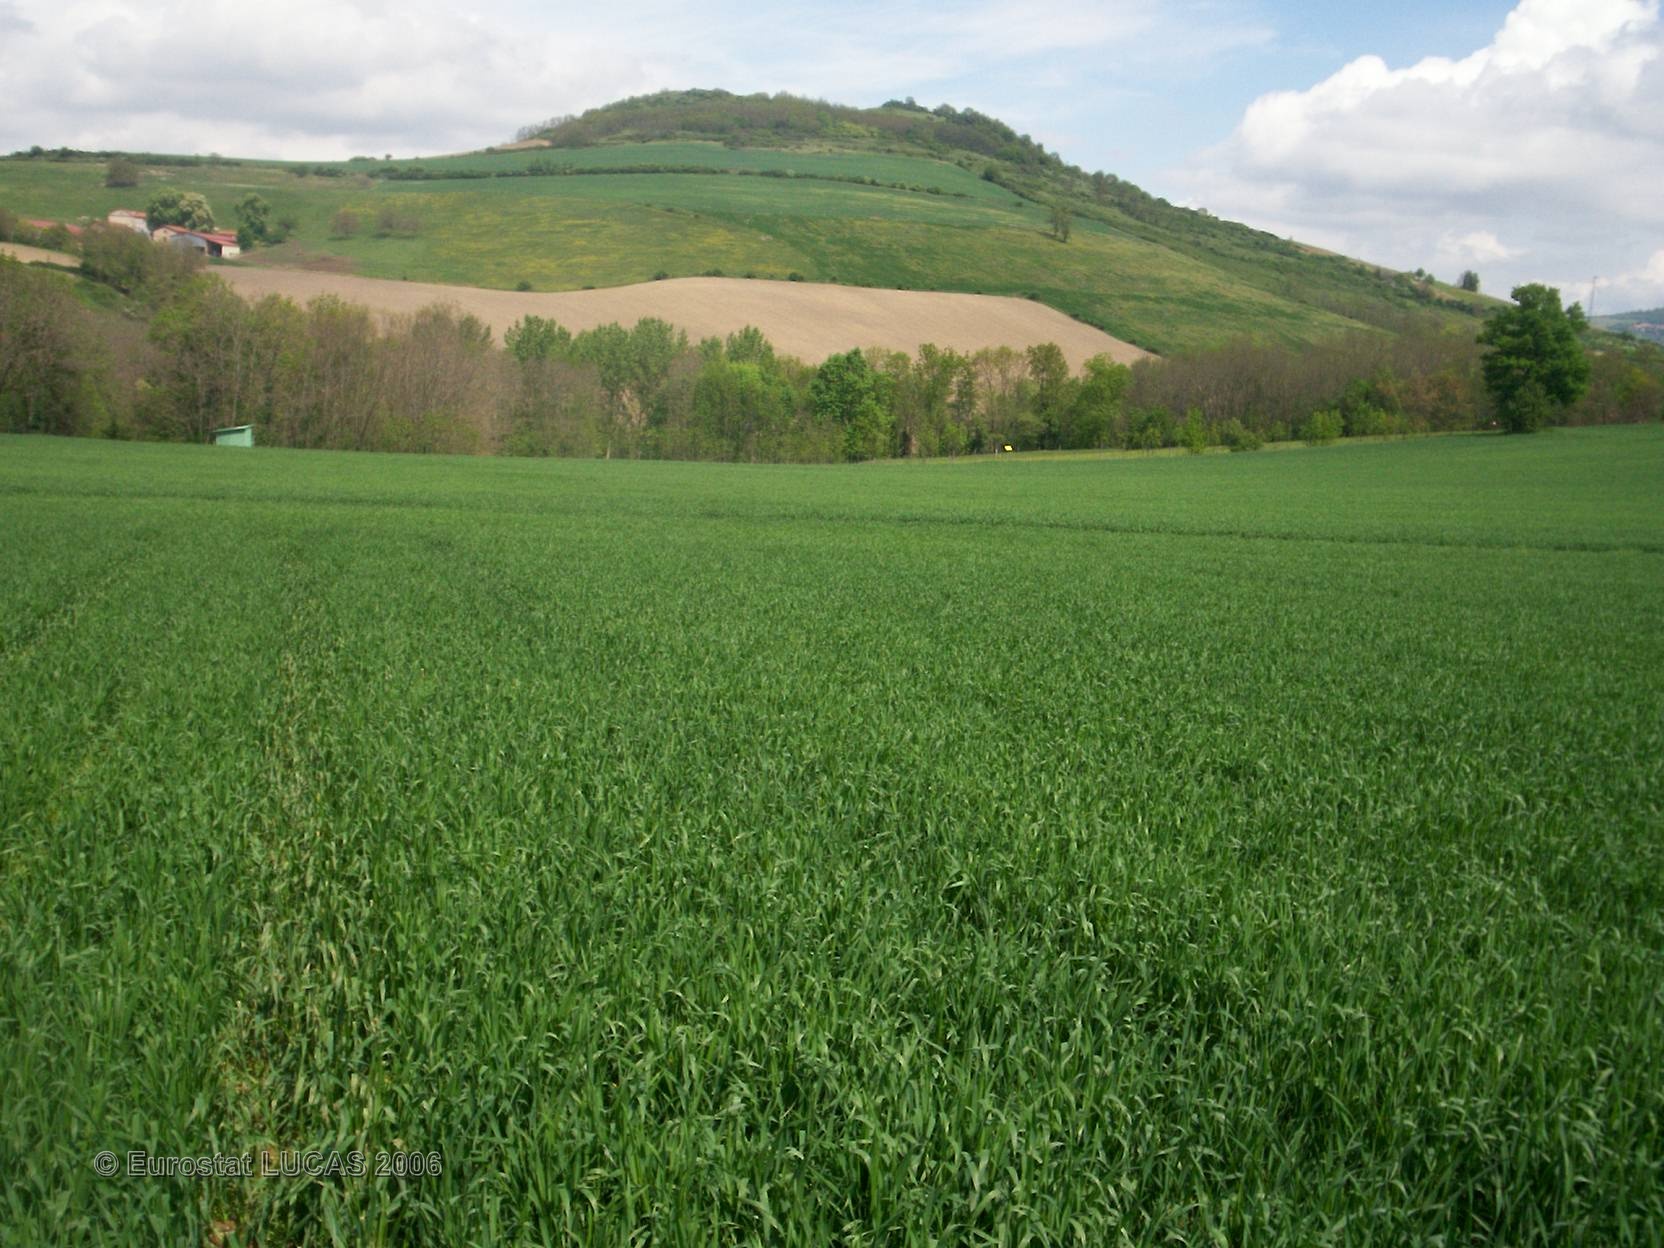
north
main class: Cropland
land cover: Common wheat
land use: Agriculture (excluding fallow land and kitchen gardens)
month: May
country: FR
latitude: 45.5757
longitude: 3.2217
